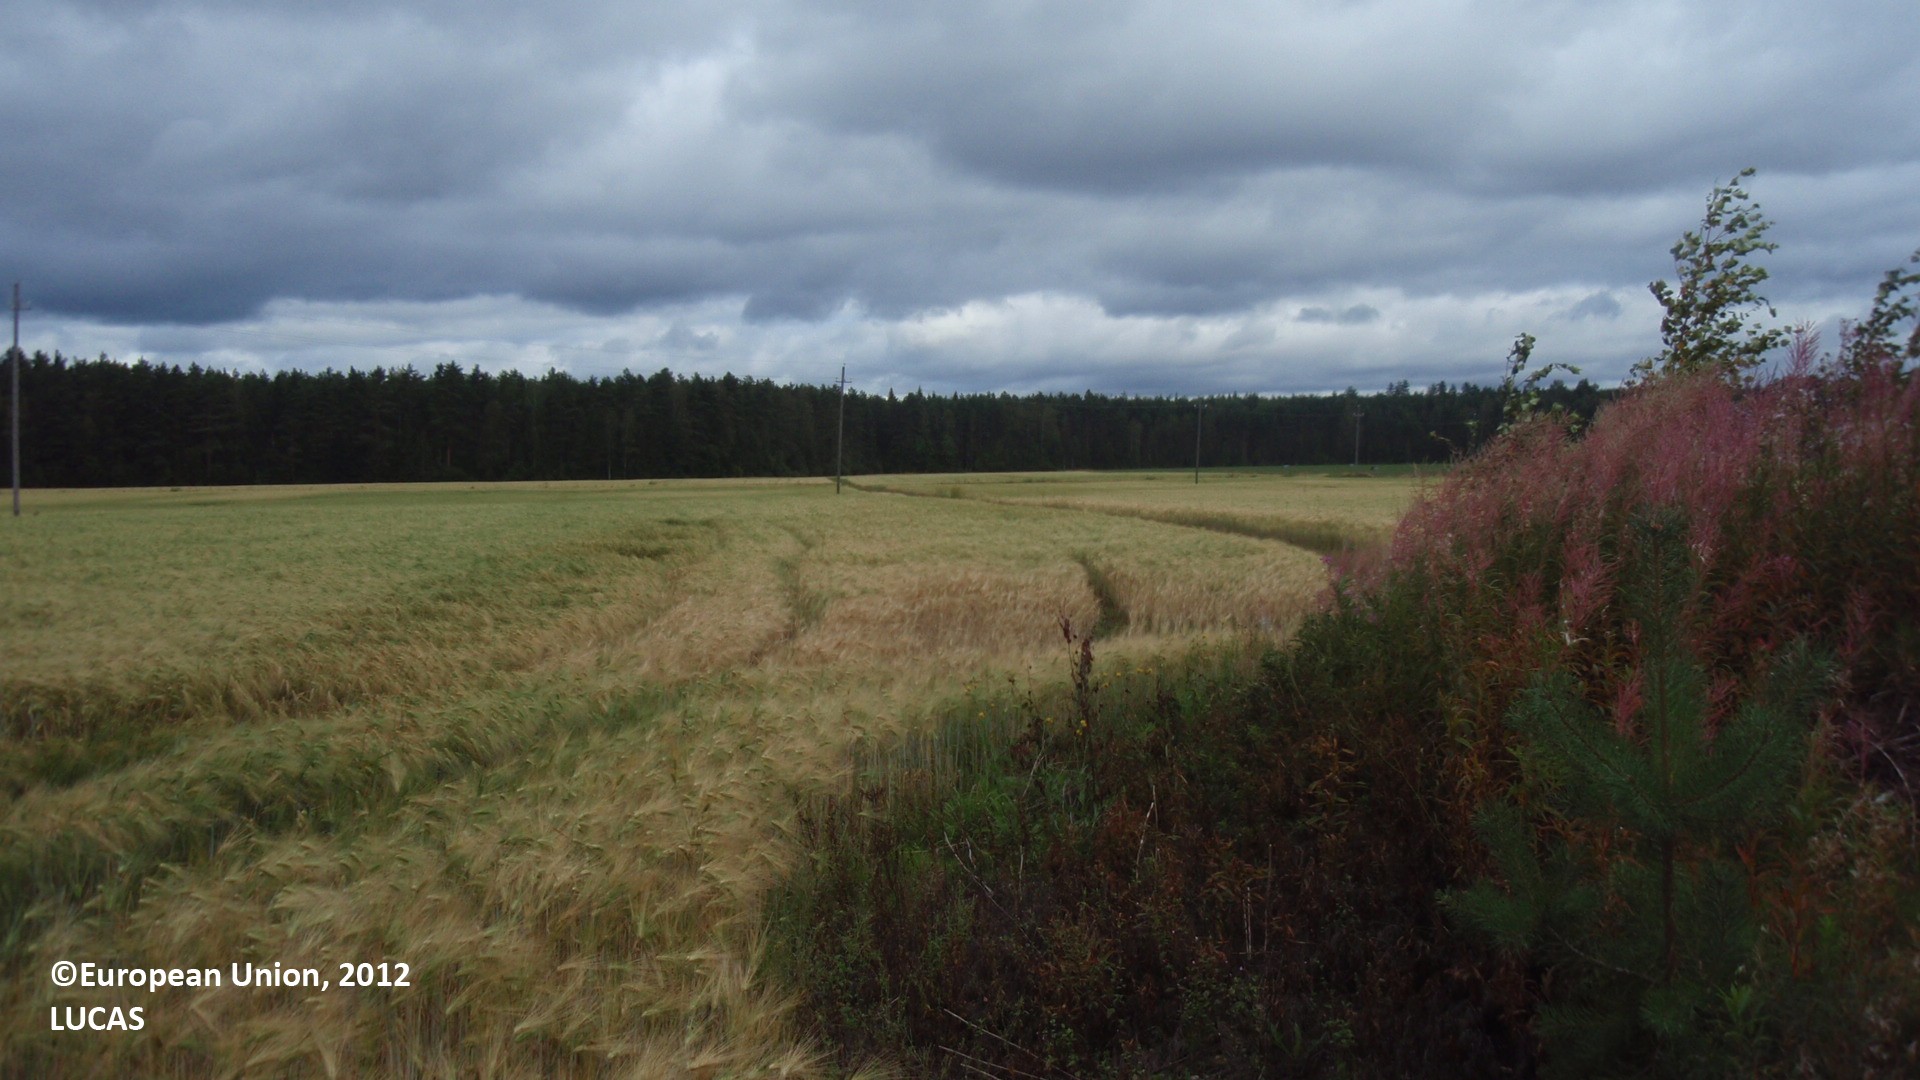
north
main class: Cropland
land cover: Barley
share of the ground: > 75 %
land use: Agriculture (excluding fallow land and kitchen gardens)
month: August
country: FI
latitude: 60.8941
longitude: 26.9934
